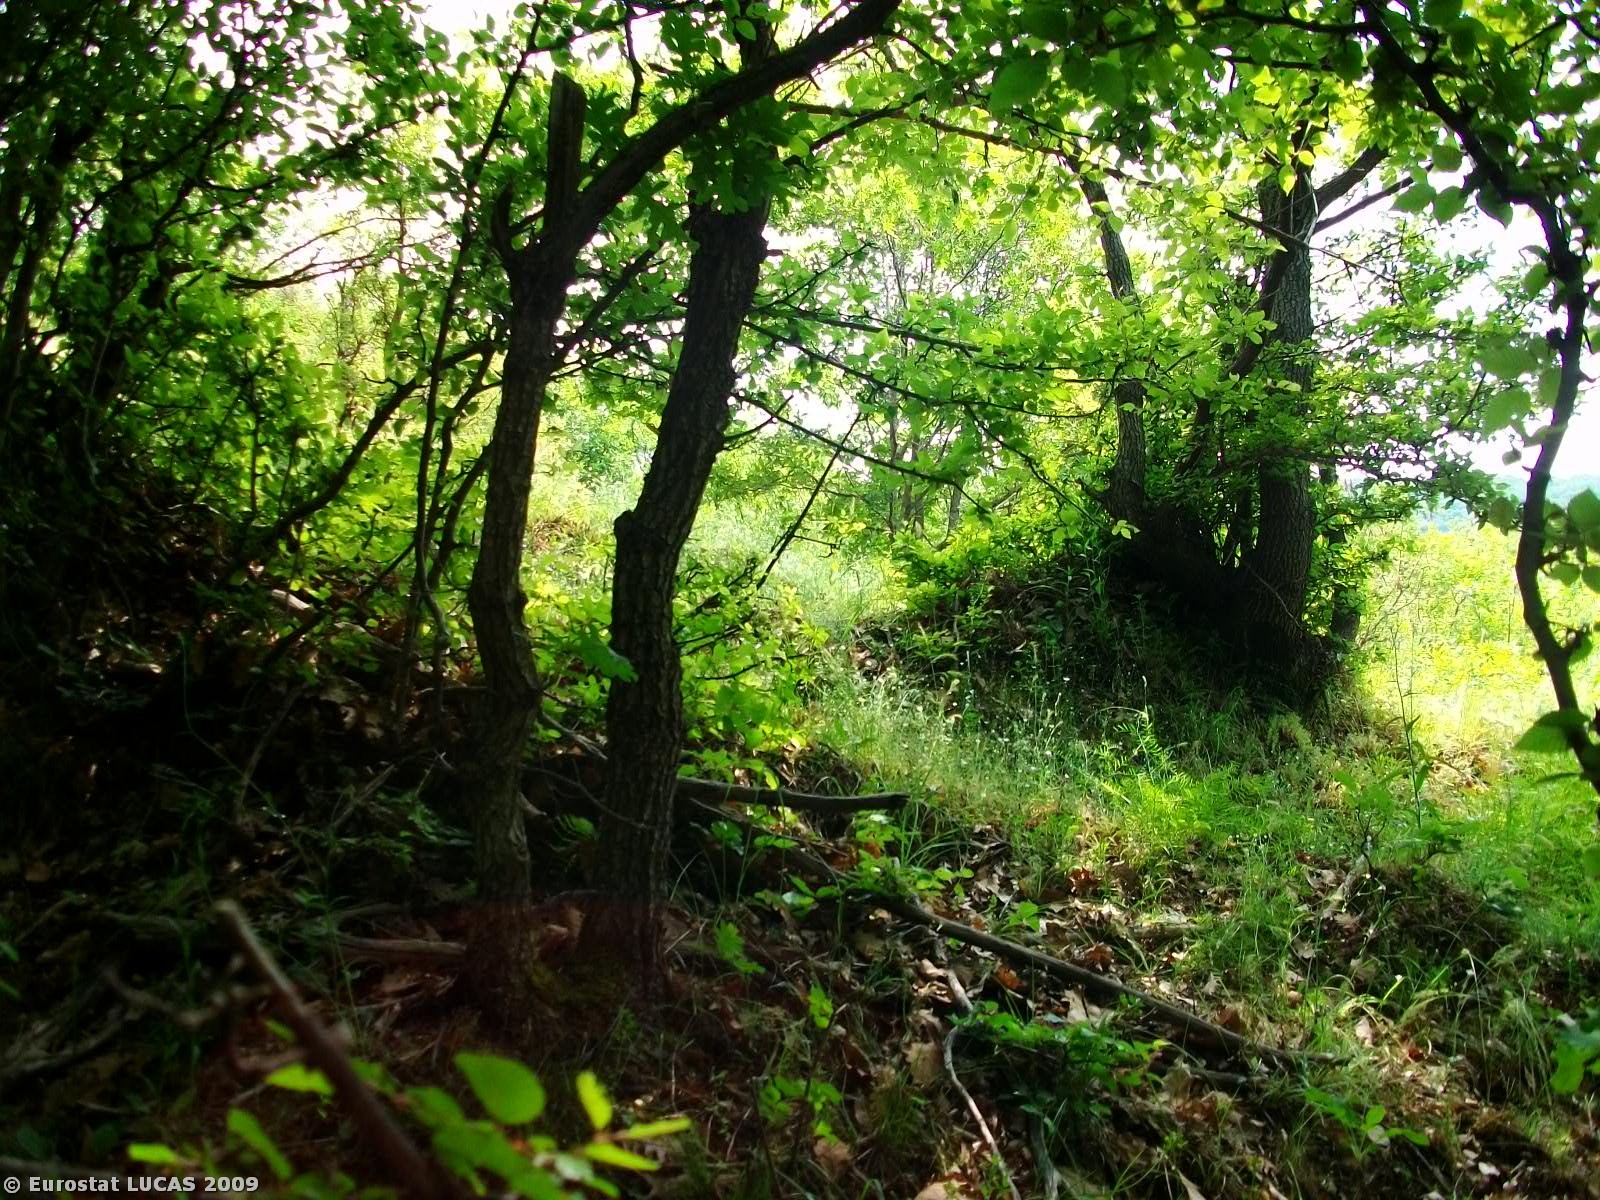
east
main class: Woodland
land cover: Broadleaved woodland
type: mesophytic deciduous forest
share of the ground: > 75 %
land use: Forestry
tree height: > 5 m
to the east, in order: Broadleaved woodland; Rivers and streams; Broadleaved woodland; Paved roads, cycling and walking lanes; Broadleaved woodland
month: May
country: GR
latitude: 41.2594
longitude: 25.5596
